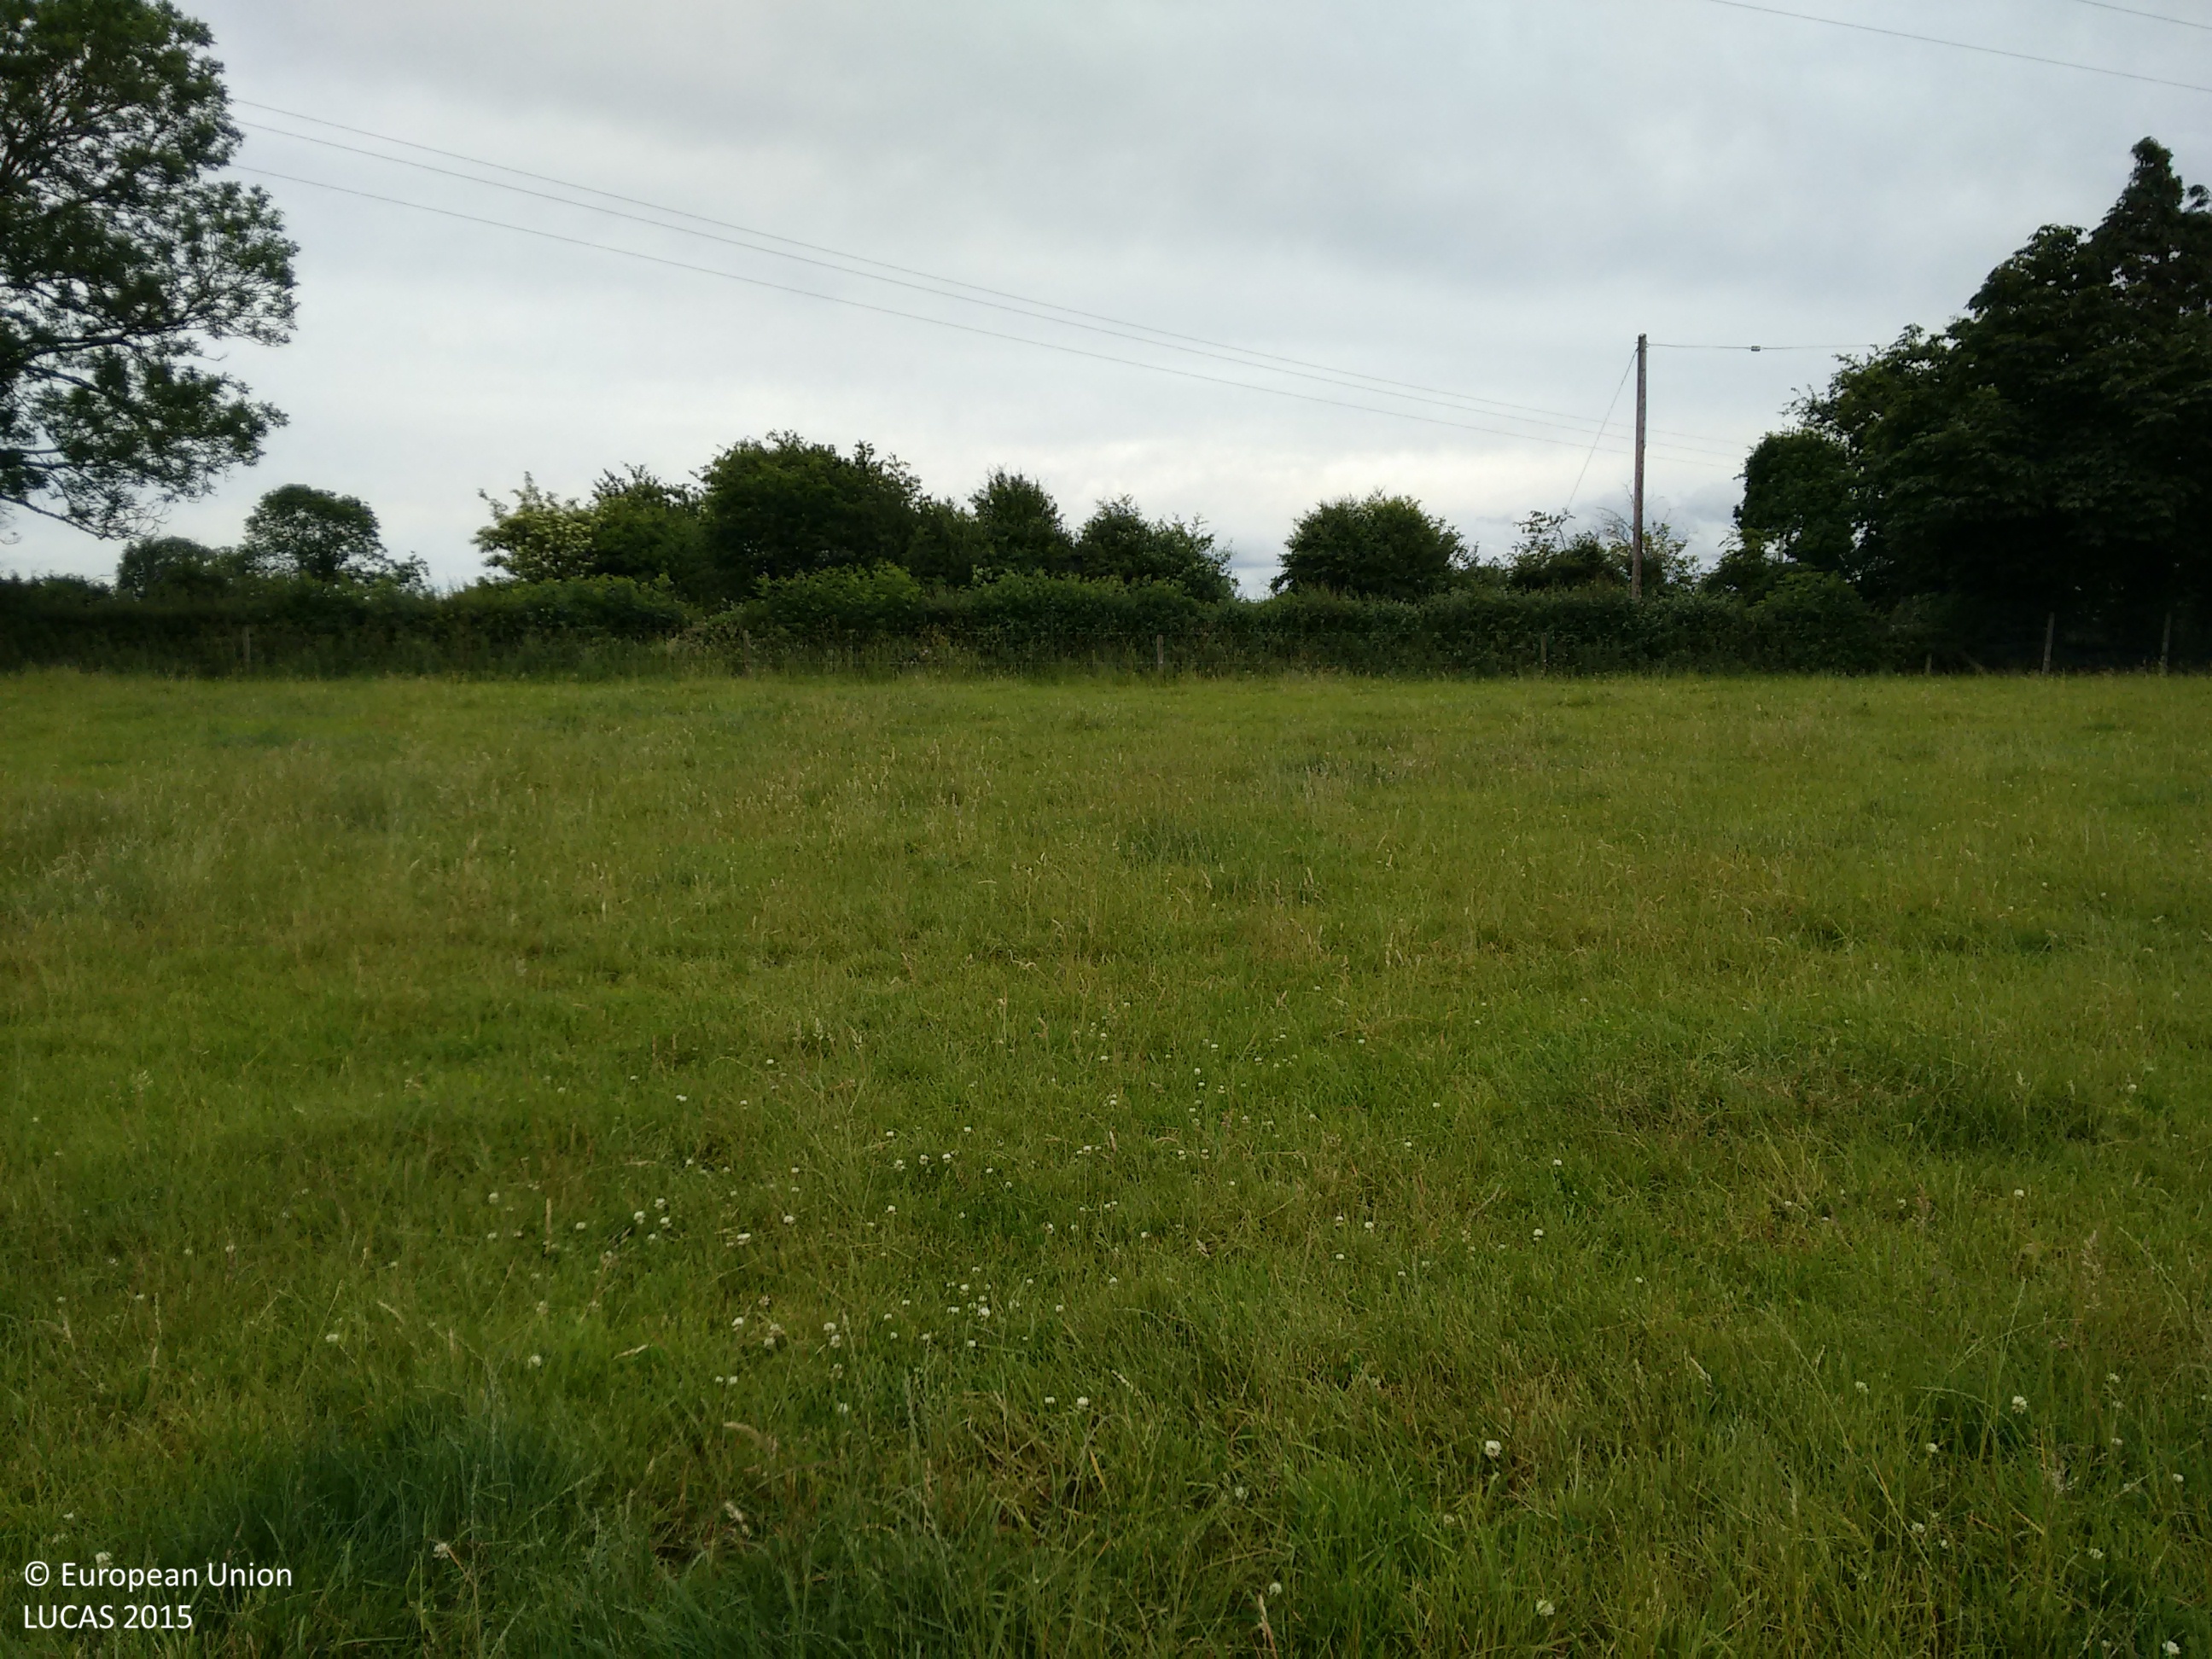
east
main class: Grassland
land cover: Grassland without tree/shrub cover
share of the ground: > 75 %
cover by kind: herbaceous plants 100 %
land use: Agriculture (excluding fallow land and kitchen gardens)
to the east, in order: Grassland without tree/shrub cover; Fences; Abandoned hedges; Tracks; Electric lines; Abandoned hedges; Grassland without tree/shrub cover; Fences; Abandoned hedges; Grassland without tree/shrub cover
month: July
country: IE
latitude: 52.5518
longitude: -7.3961
